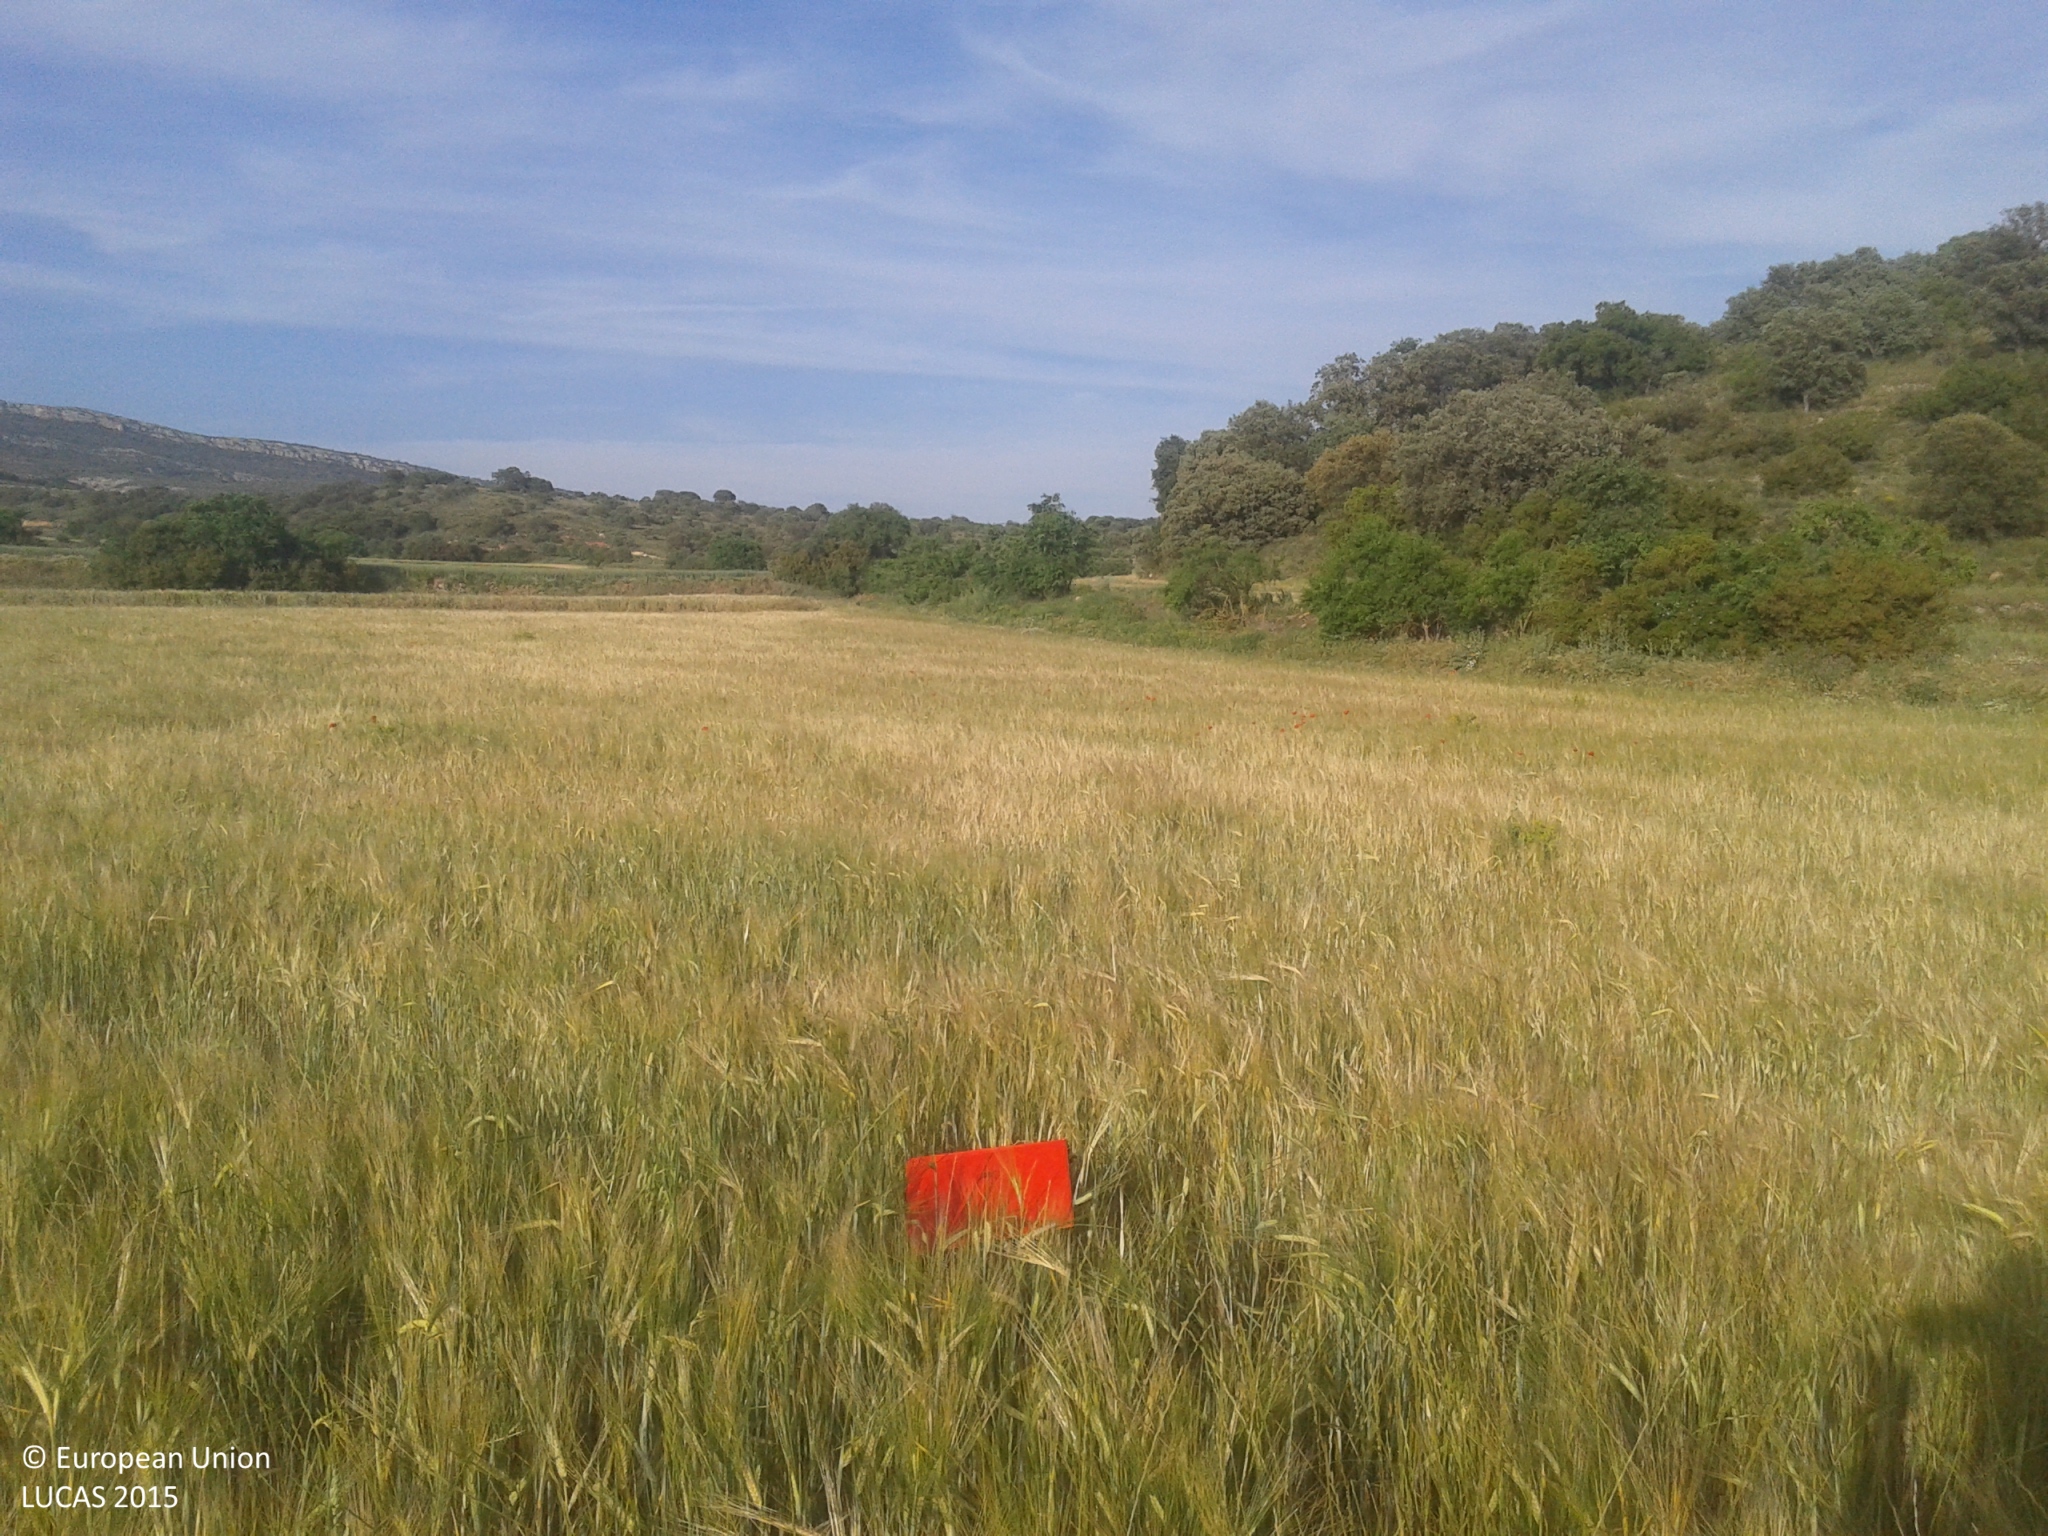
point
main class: Cropland
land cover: Rye
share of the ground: > 75 %
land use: Agriculture (excluding fallow land and kitchen gardens)
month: May
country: ES
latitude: 41.8573
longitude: 0.6503
